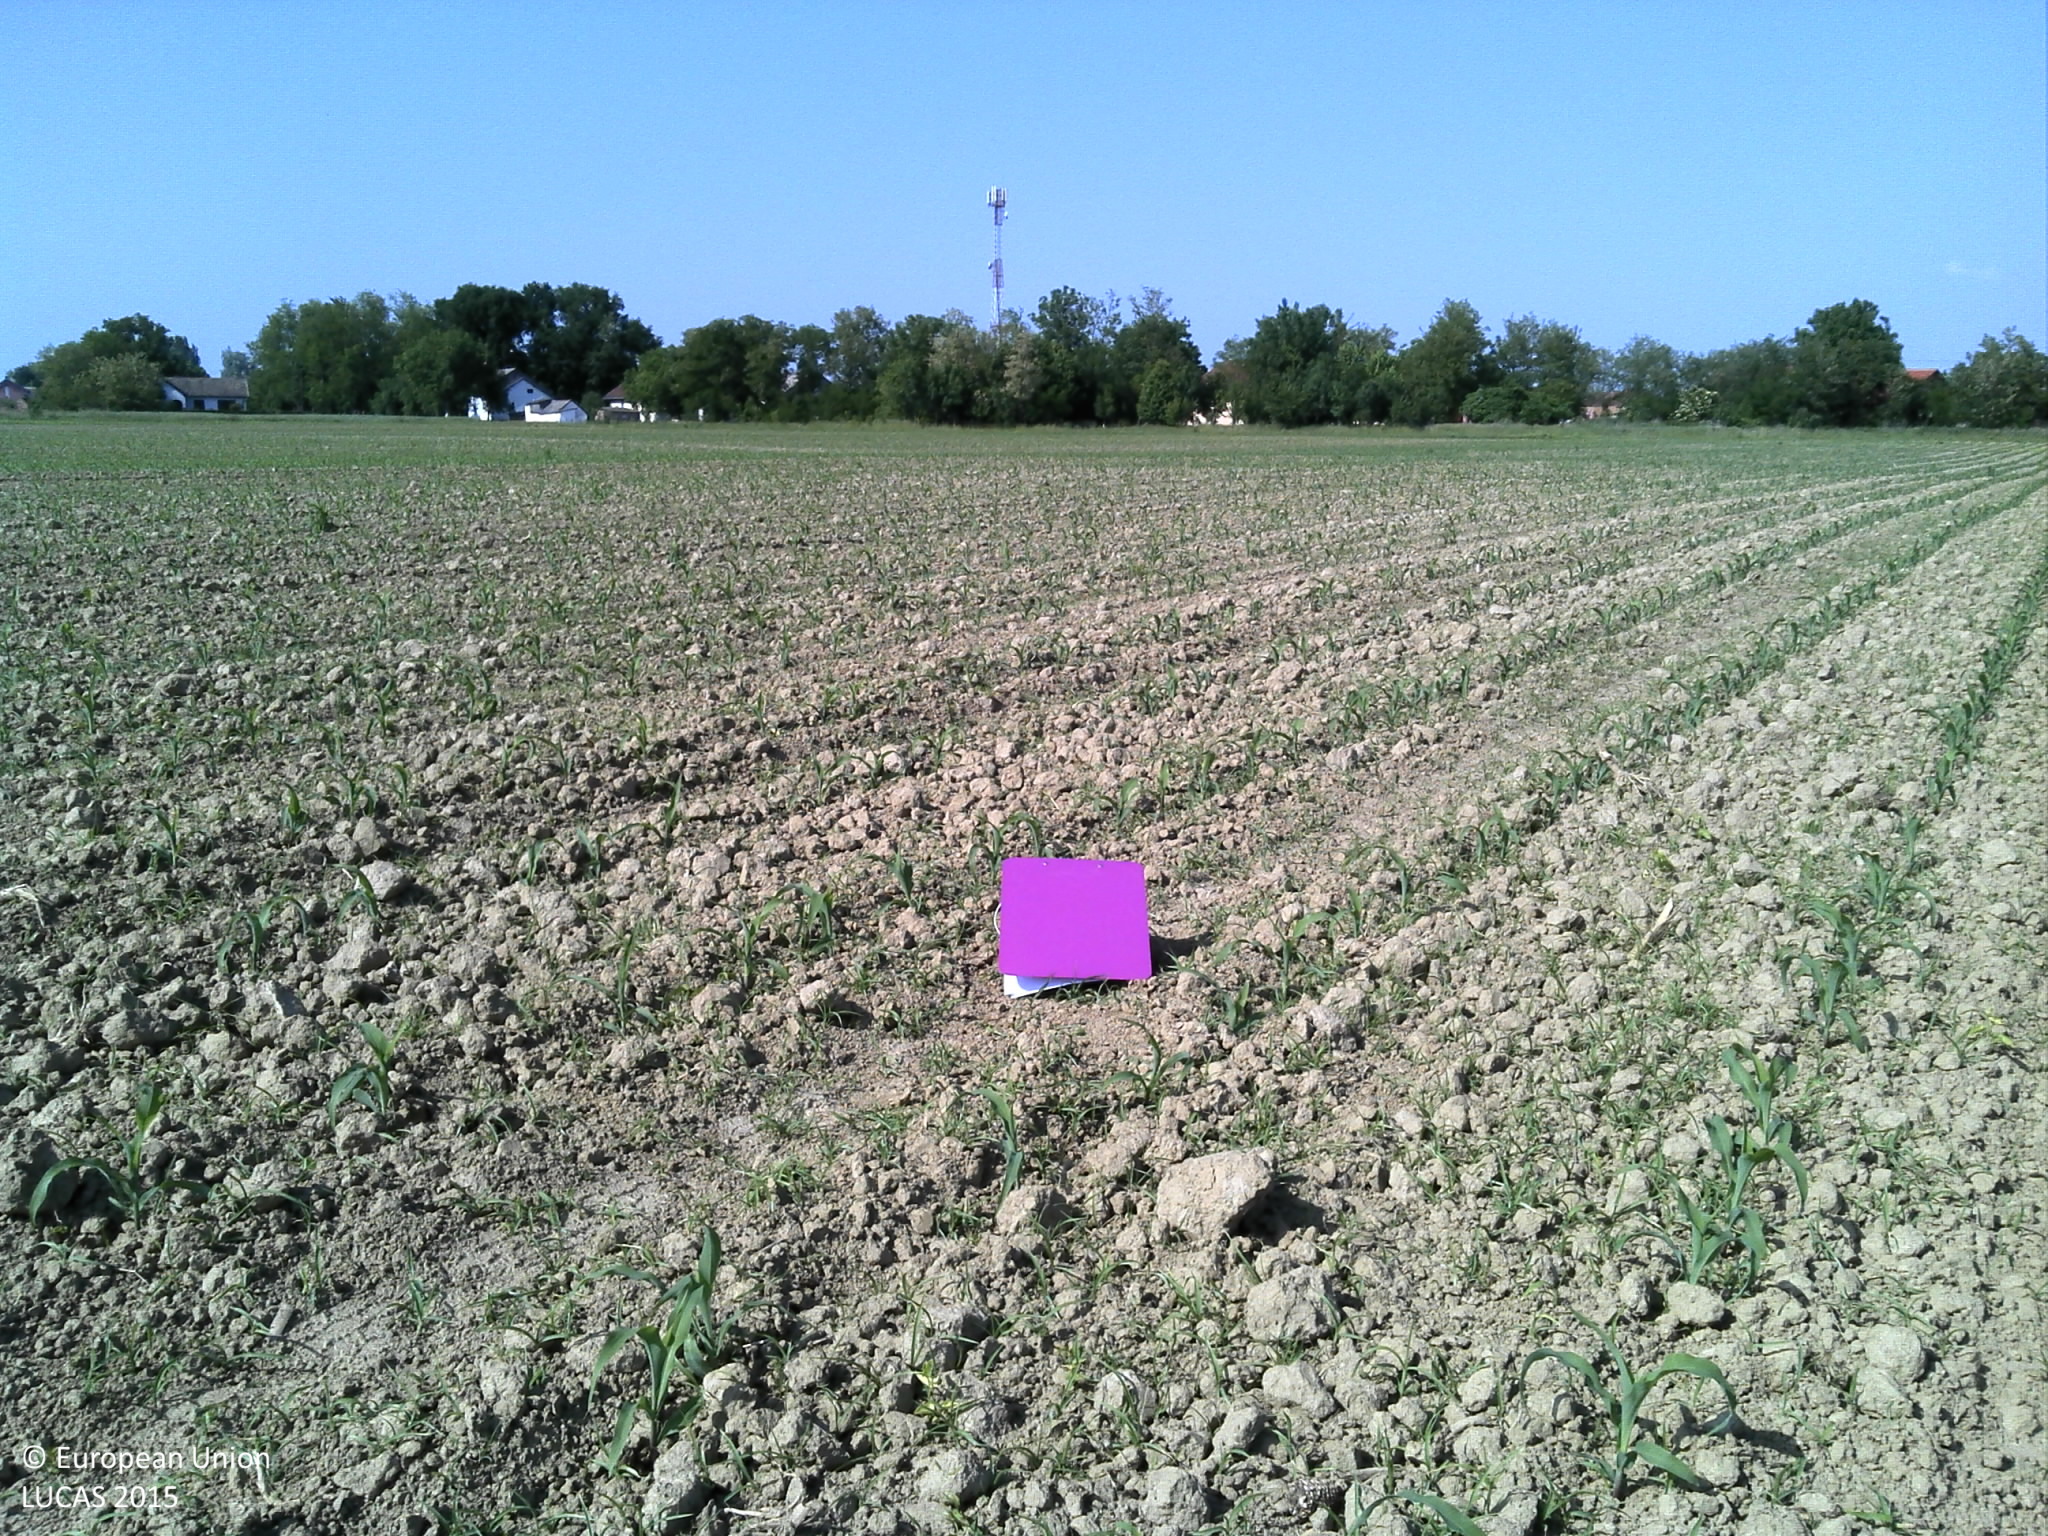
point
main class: Cropland
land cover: Maize
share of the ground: < 10 %
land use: Agriculture (excluding fallow land and kitchen gardens)
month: May
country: HR
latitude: 45.7031
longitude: 18.2904
